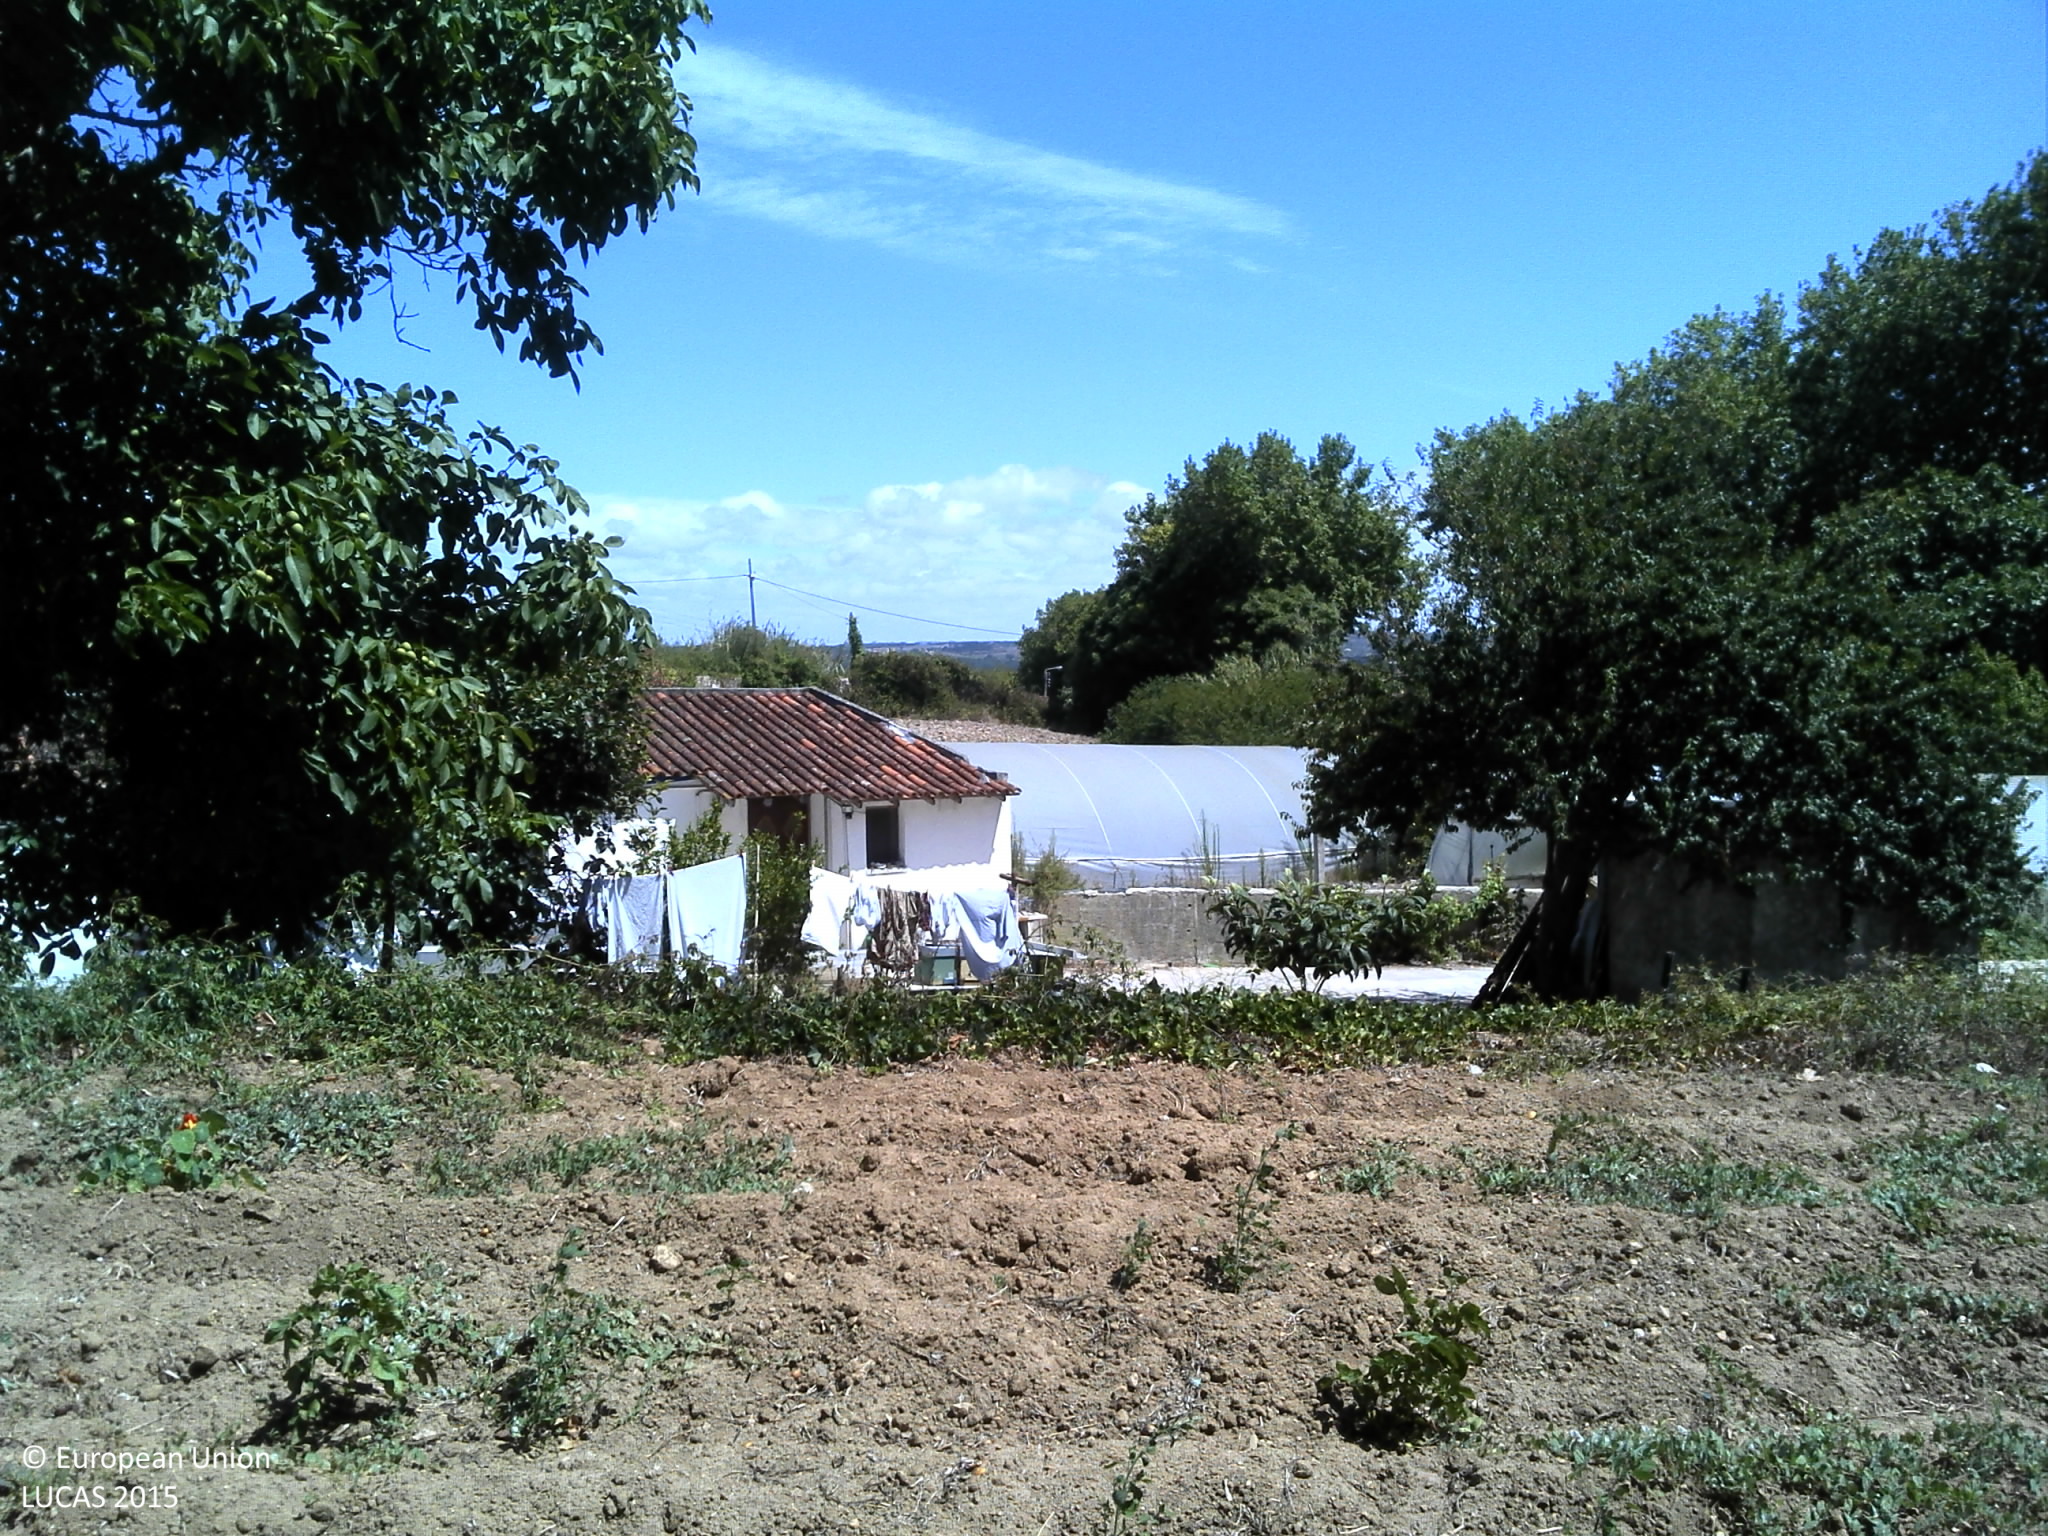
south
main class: Grassland
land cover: Grassland without tree/shrub cover
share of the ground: 25 - 50 %
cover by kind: unconsolidated bare surface 70 %, herbaceous plants 30 %
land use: Agriculture (excluding fallow land and kitchen gardens)
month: August
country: PT
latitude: 38.7973
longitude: -9.4643
